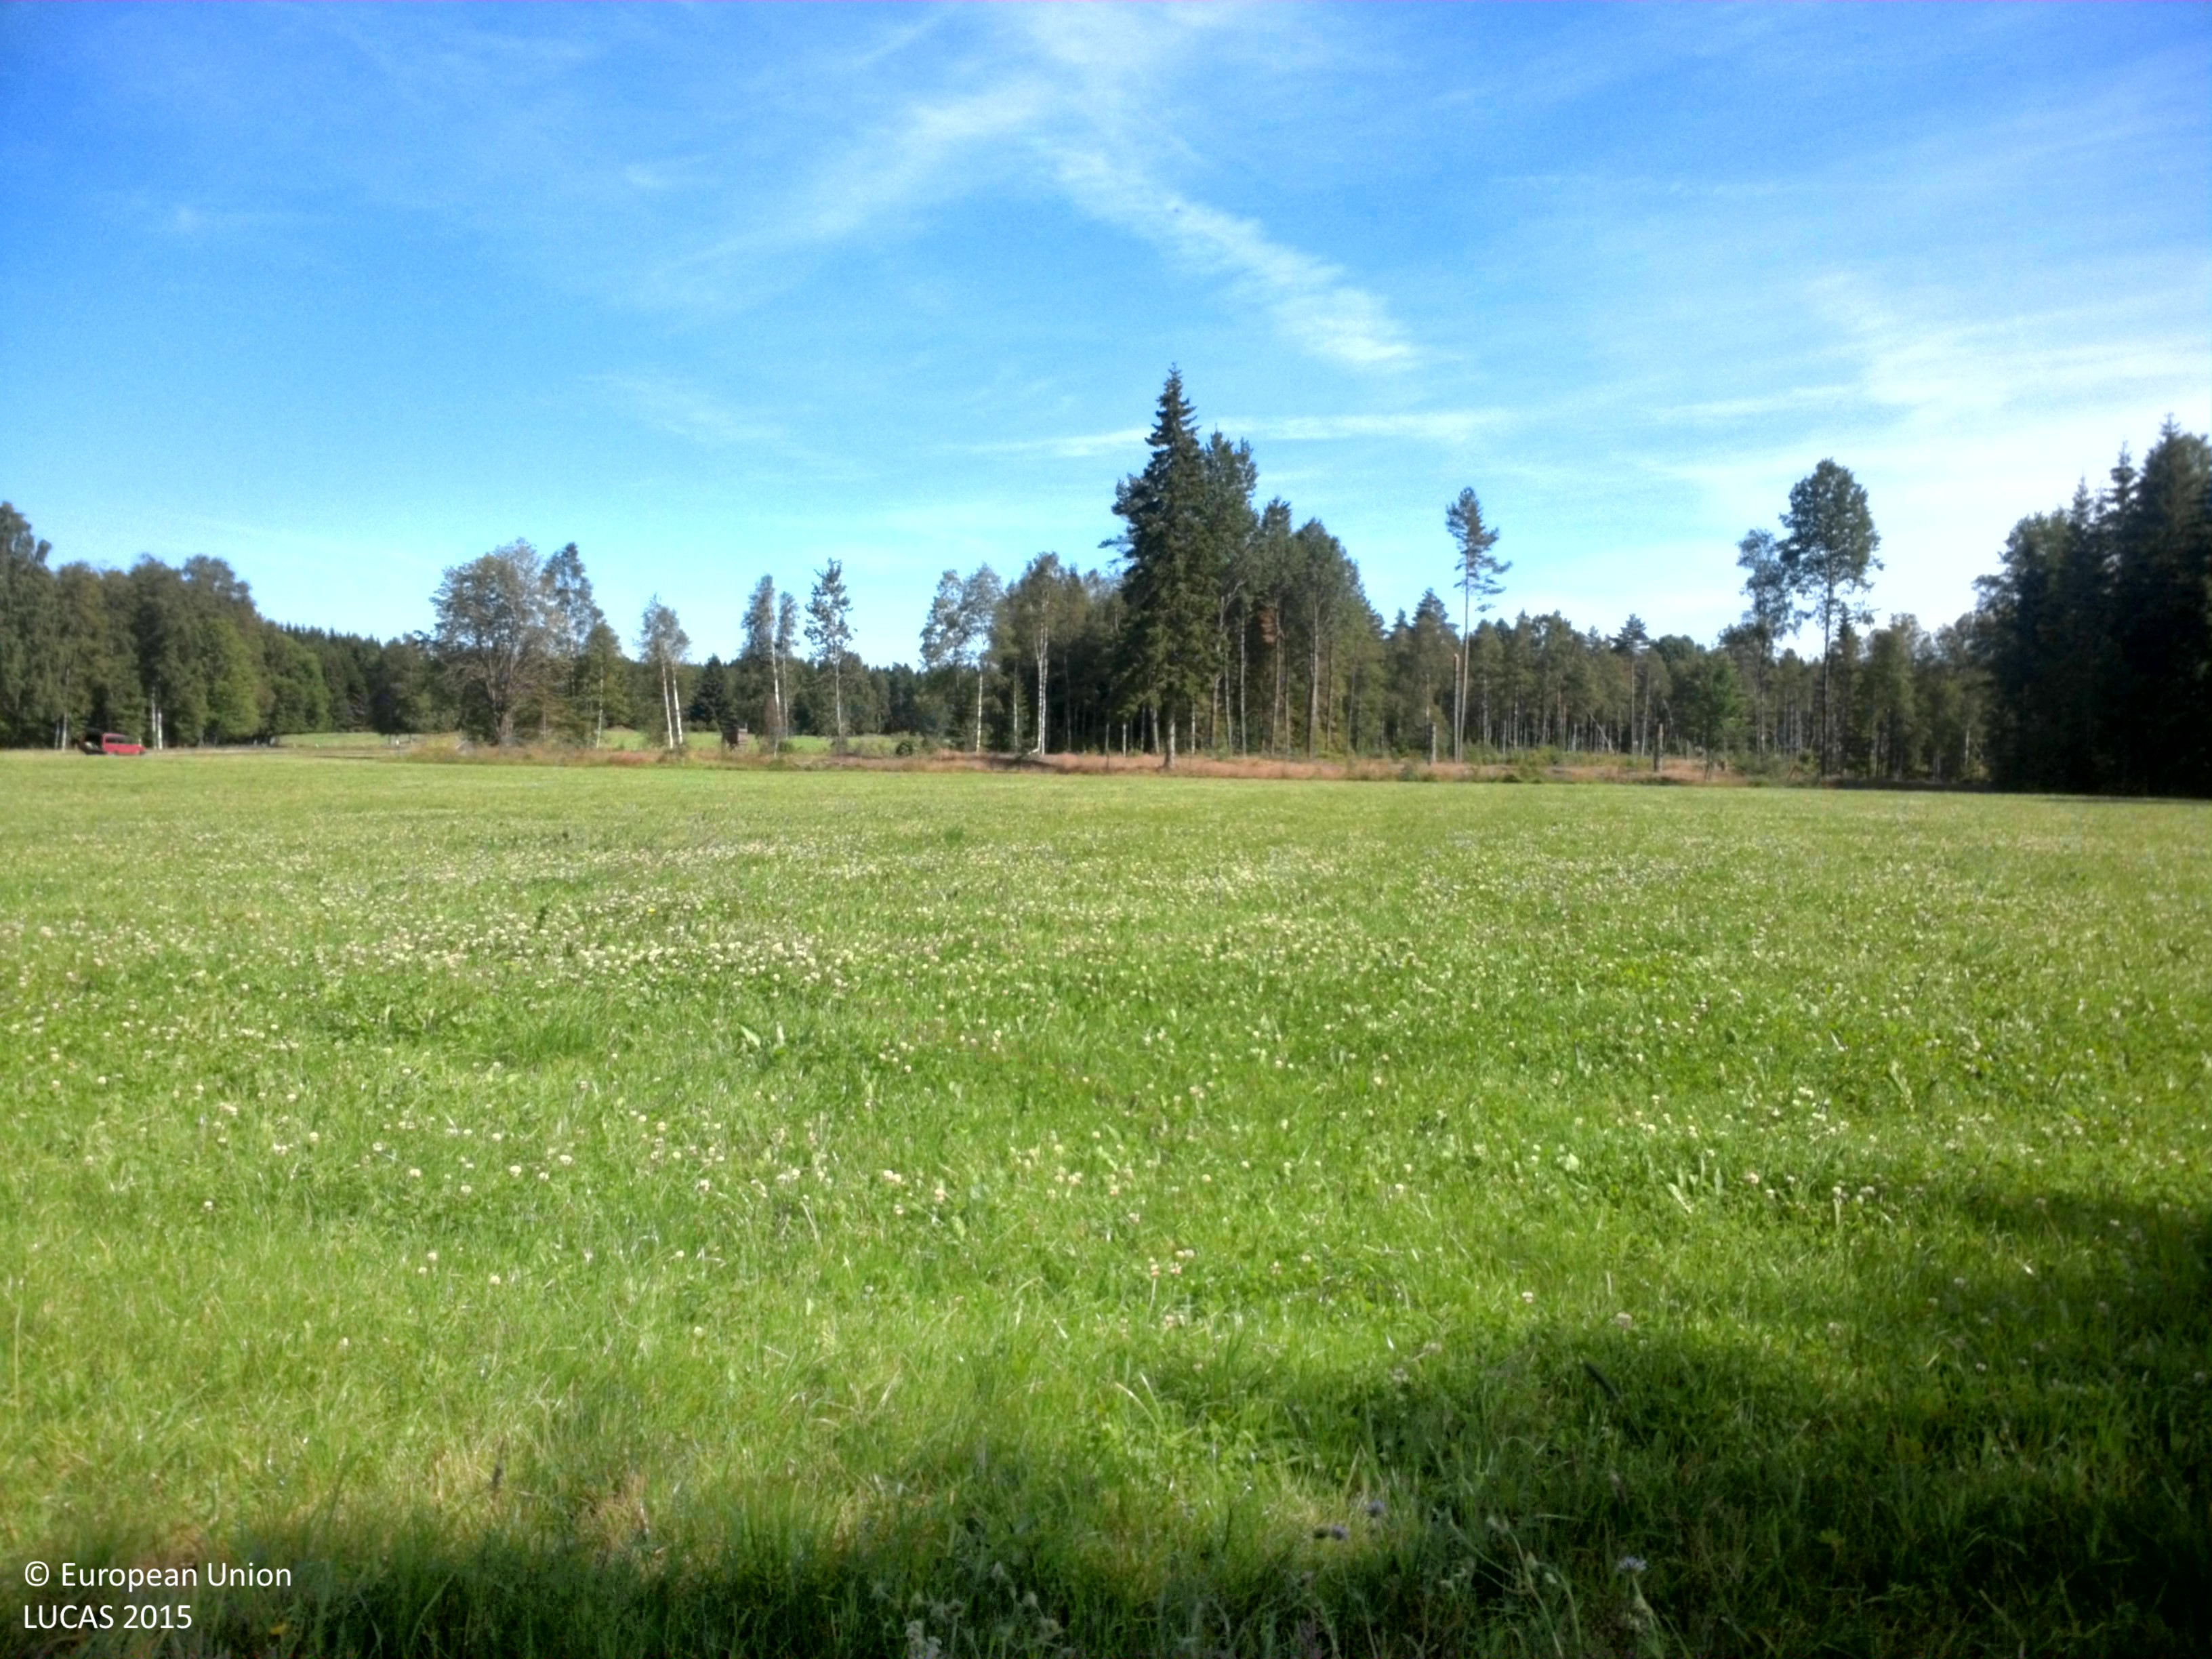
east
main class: Grassland
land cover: Grassland with sparse tree/shrub cover
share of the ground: > 75 %
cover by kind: herbaceous plants 90 %, broadleaved forest trees 5 %, shrubs 5 %
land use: Agriculture (excluding fallow land and kitchen gardens)
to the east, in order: Grassland with sparse tree/shrub cover; Temporary grasslands; Paved roads, cycling and walking lanes; Fences; Grassland without tree/shrub cover; Shrubland with sparse tree cover; Shrubland without tree cover; Grassland with sparse tree/shrub cover
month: July
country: SE
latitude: 57.6274
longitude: 14.3324
